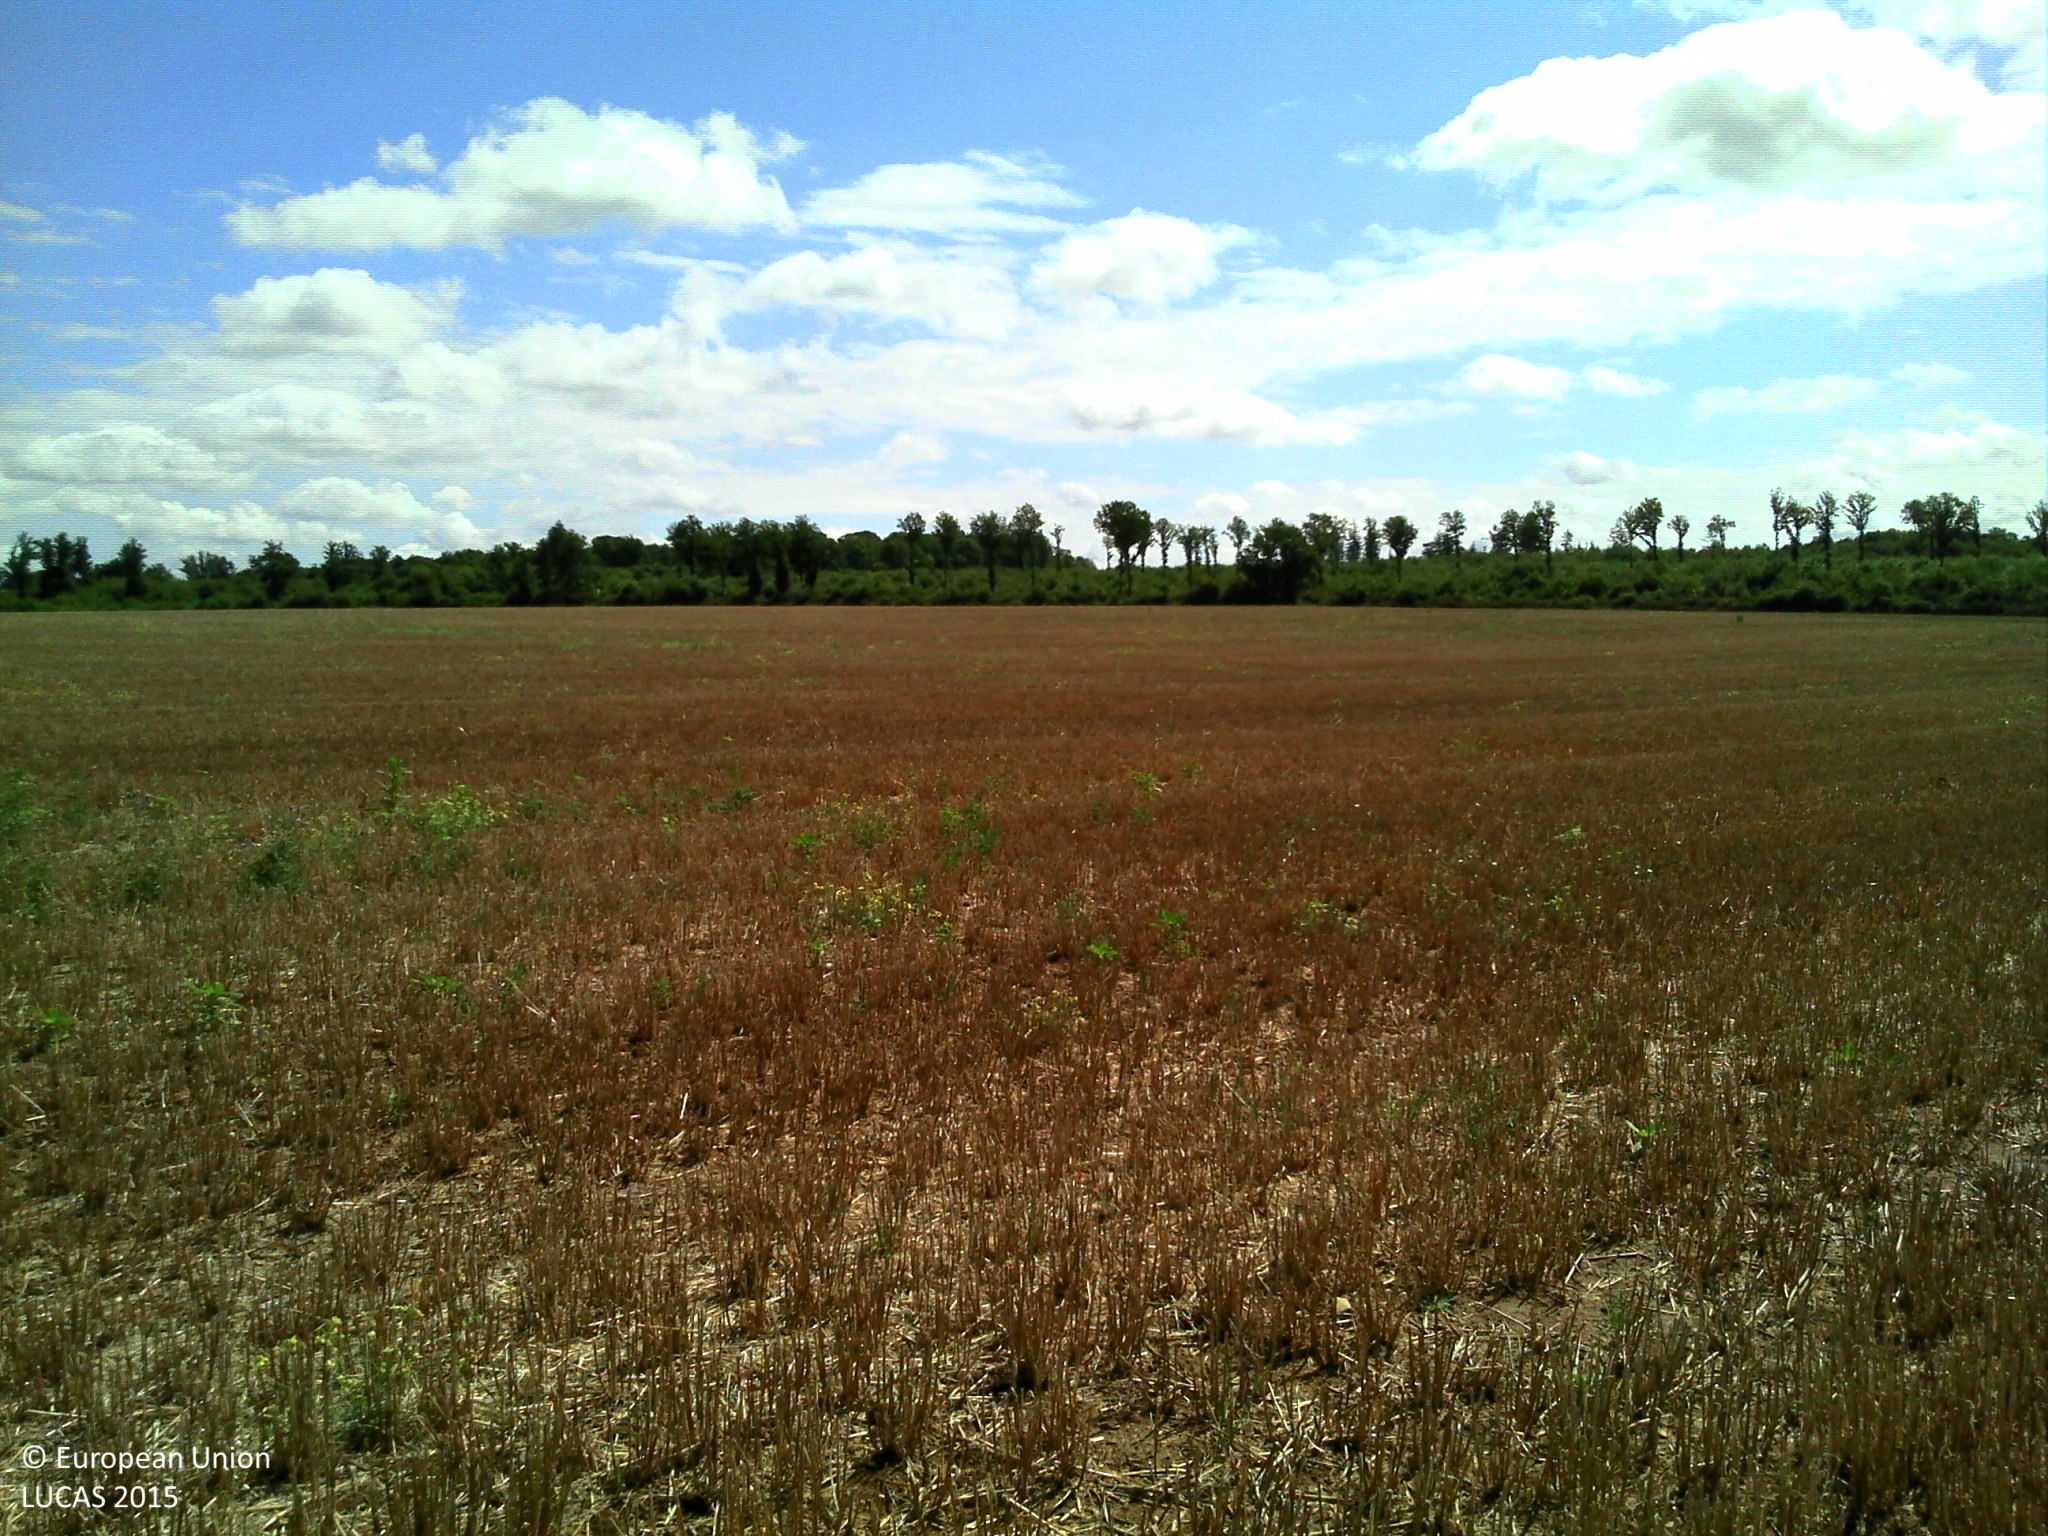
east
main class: Cropland
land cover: Barley
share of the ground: 50 - 75 %
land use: Agriculture (excluding fallow land and kitchen gardens)
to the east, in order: Barley
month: August
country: FR
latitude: 46.0950
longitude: 0.3468
